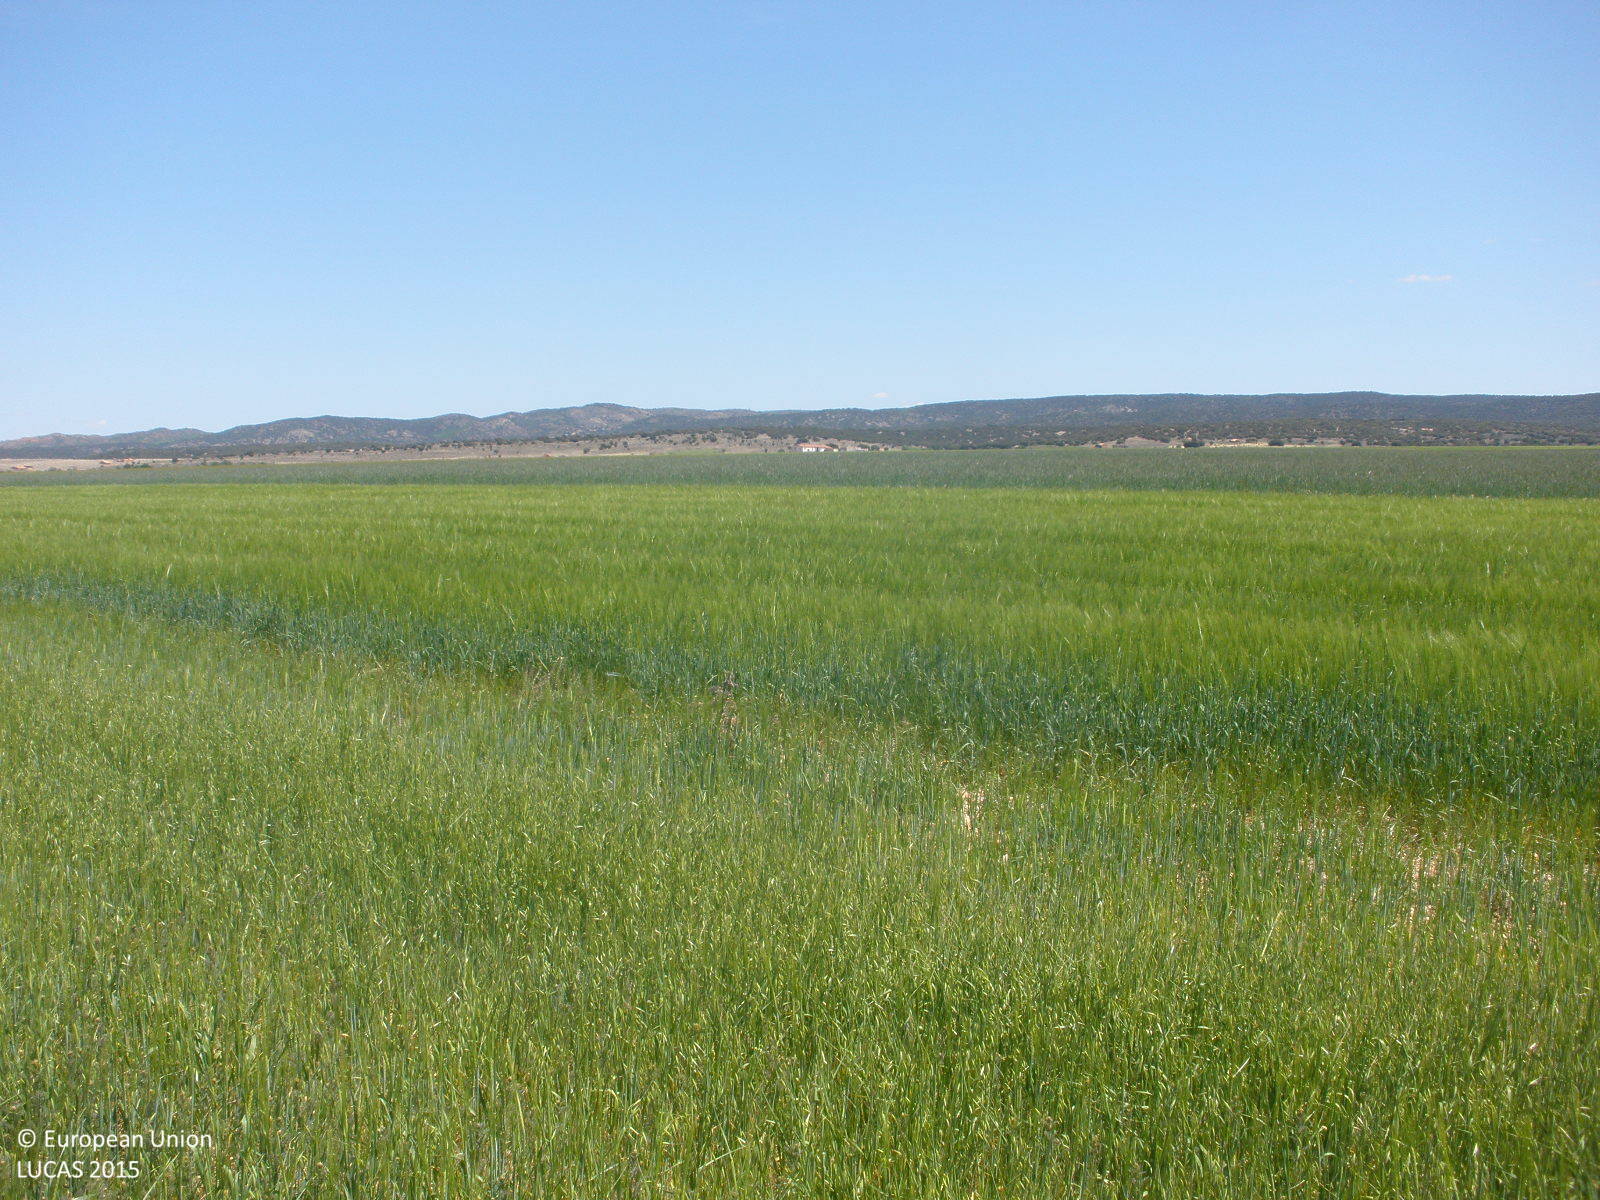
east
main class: Cropland
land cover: Barley
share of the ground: > 75 %
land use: Agriculture (excluding fallow land and kitchen gardens)
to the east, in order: Barley; Triticale; Grass margins; Triticale
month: May
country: ES
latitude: 40.7969
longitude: -1.3120
